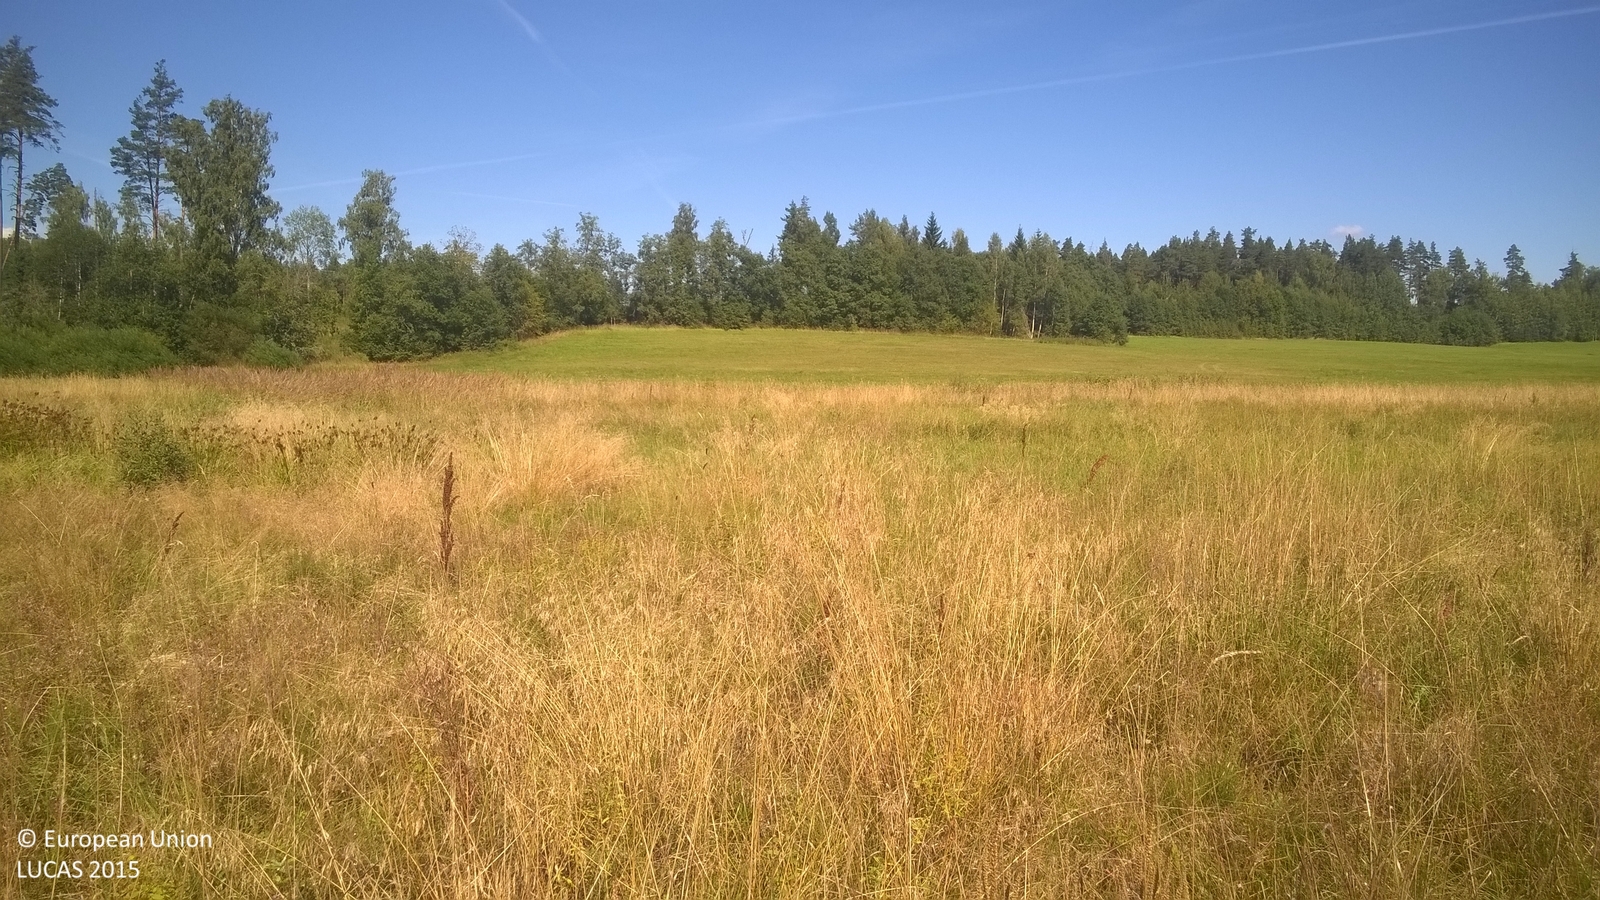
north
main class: Grassland
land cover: Spontaneously vegetated surfaces
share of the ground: > 75 %
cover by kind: herbaceous plants 95 %, shrubs 5 %
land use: Semi-natural and natural areas not in use
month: August
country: LV
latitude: 57.7141
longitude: 26.1273
